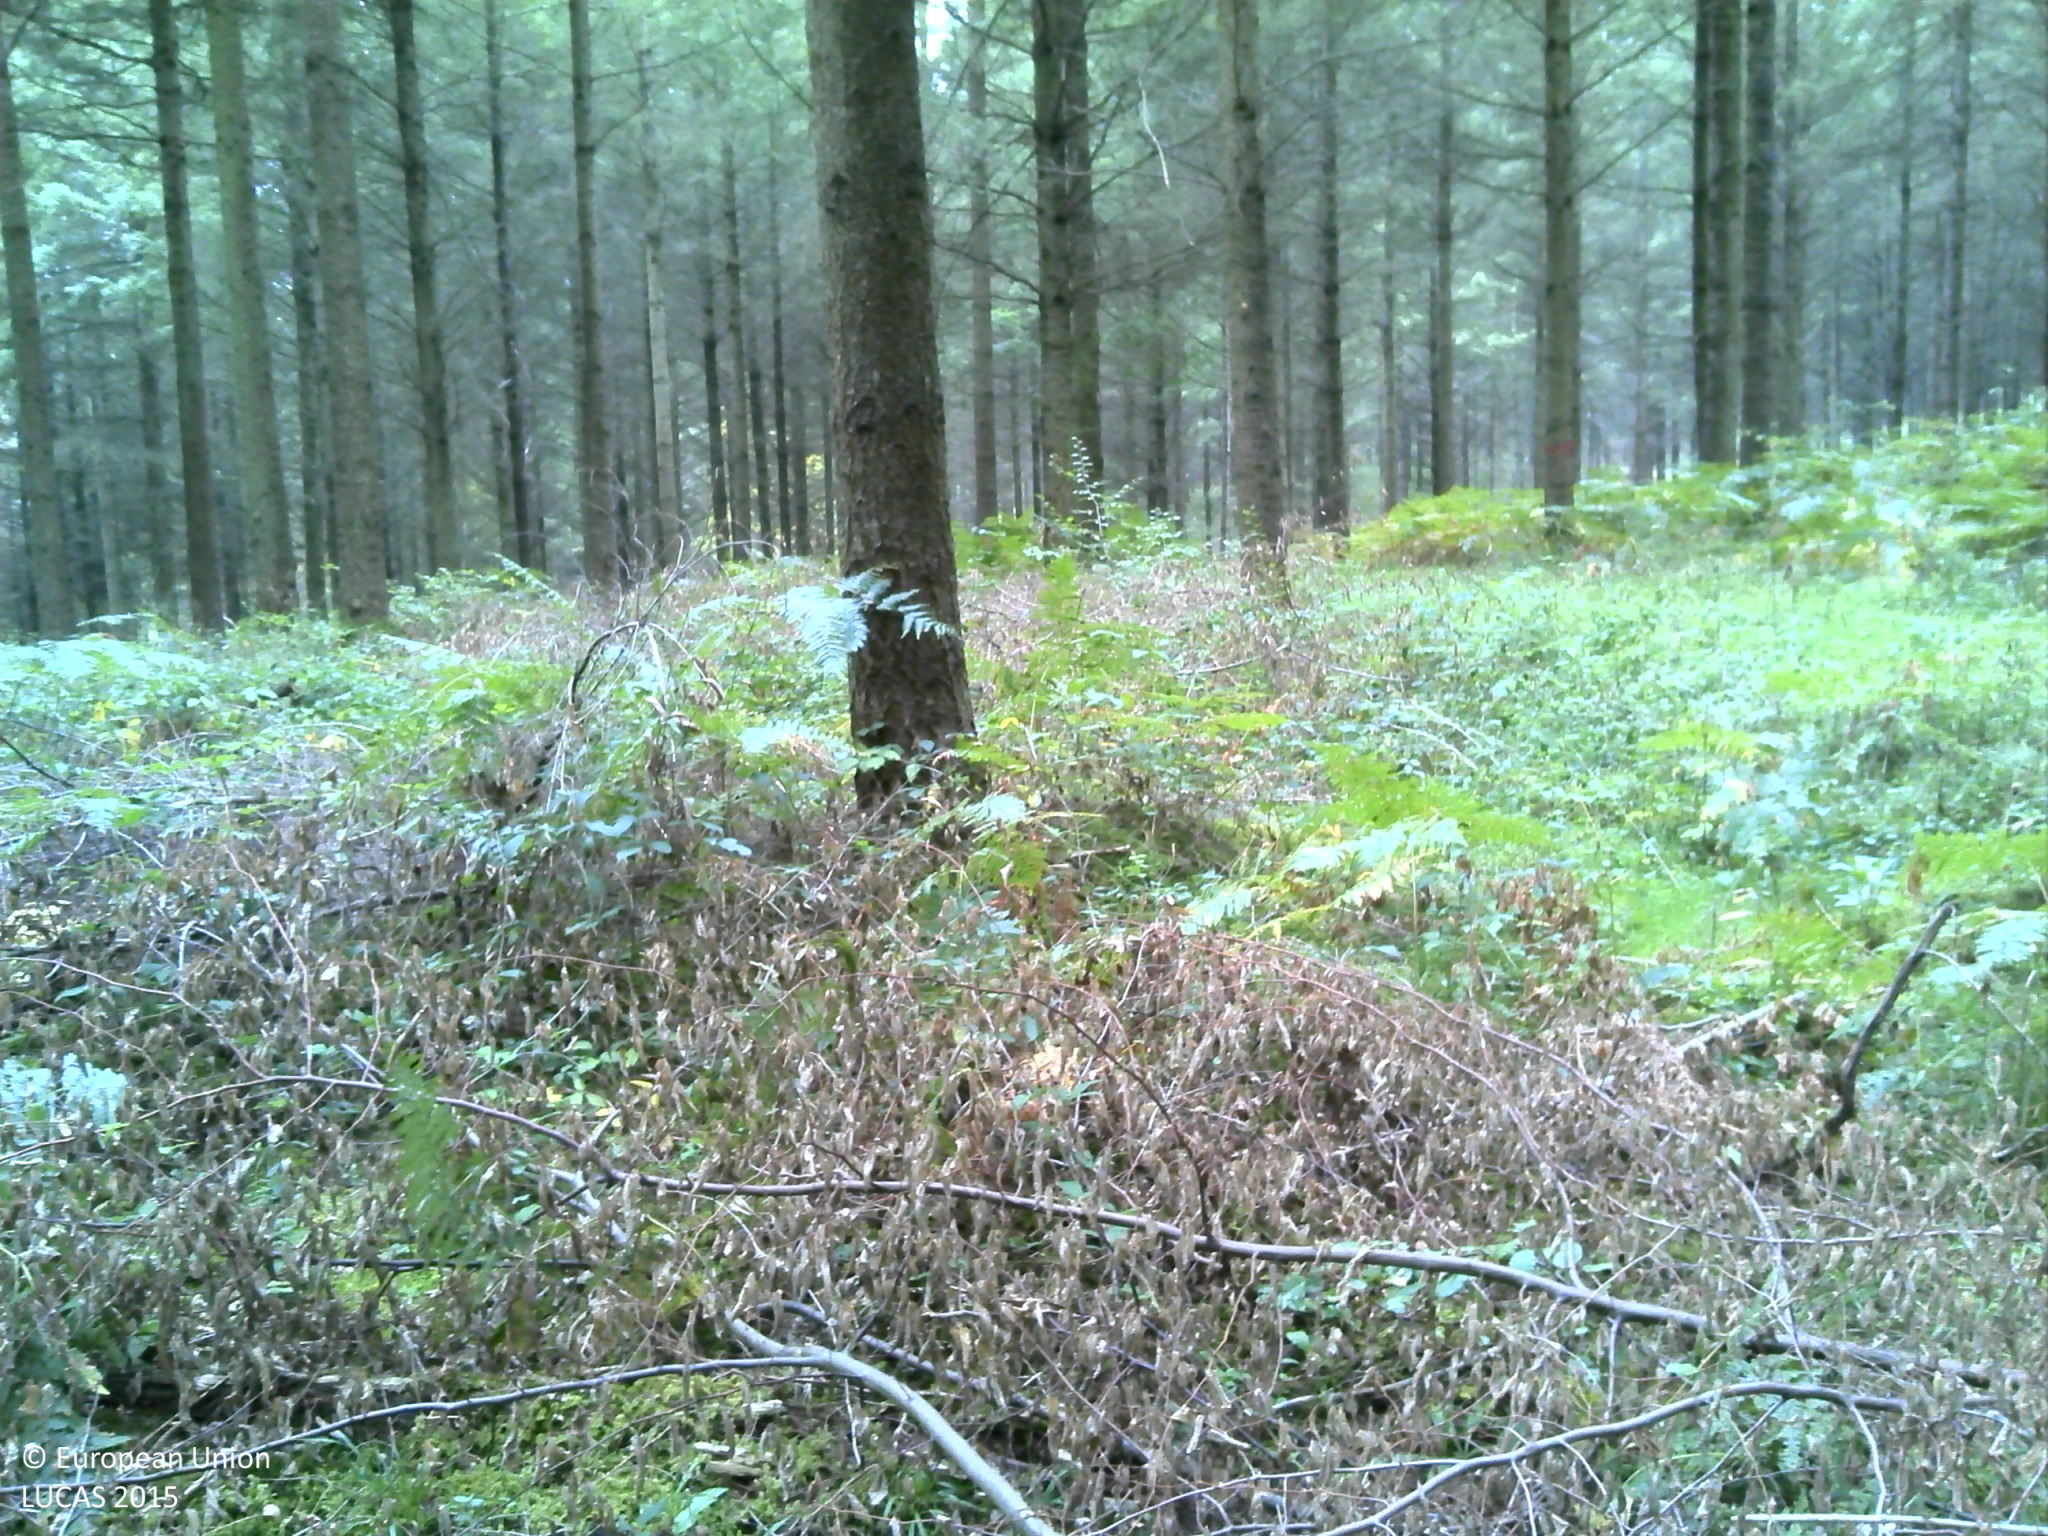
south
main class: Woodland
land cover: Other coniferous woodland
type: exotic forest
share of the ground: > 75 %
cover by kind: coniferous forest trees 85 %, herbaceous plants 15 %
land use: Forestry
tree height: > 5 m
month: October
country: FR
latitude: 46.6359
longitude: 4.0303
